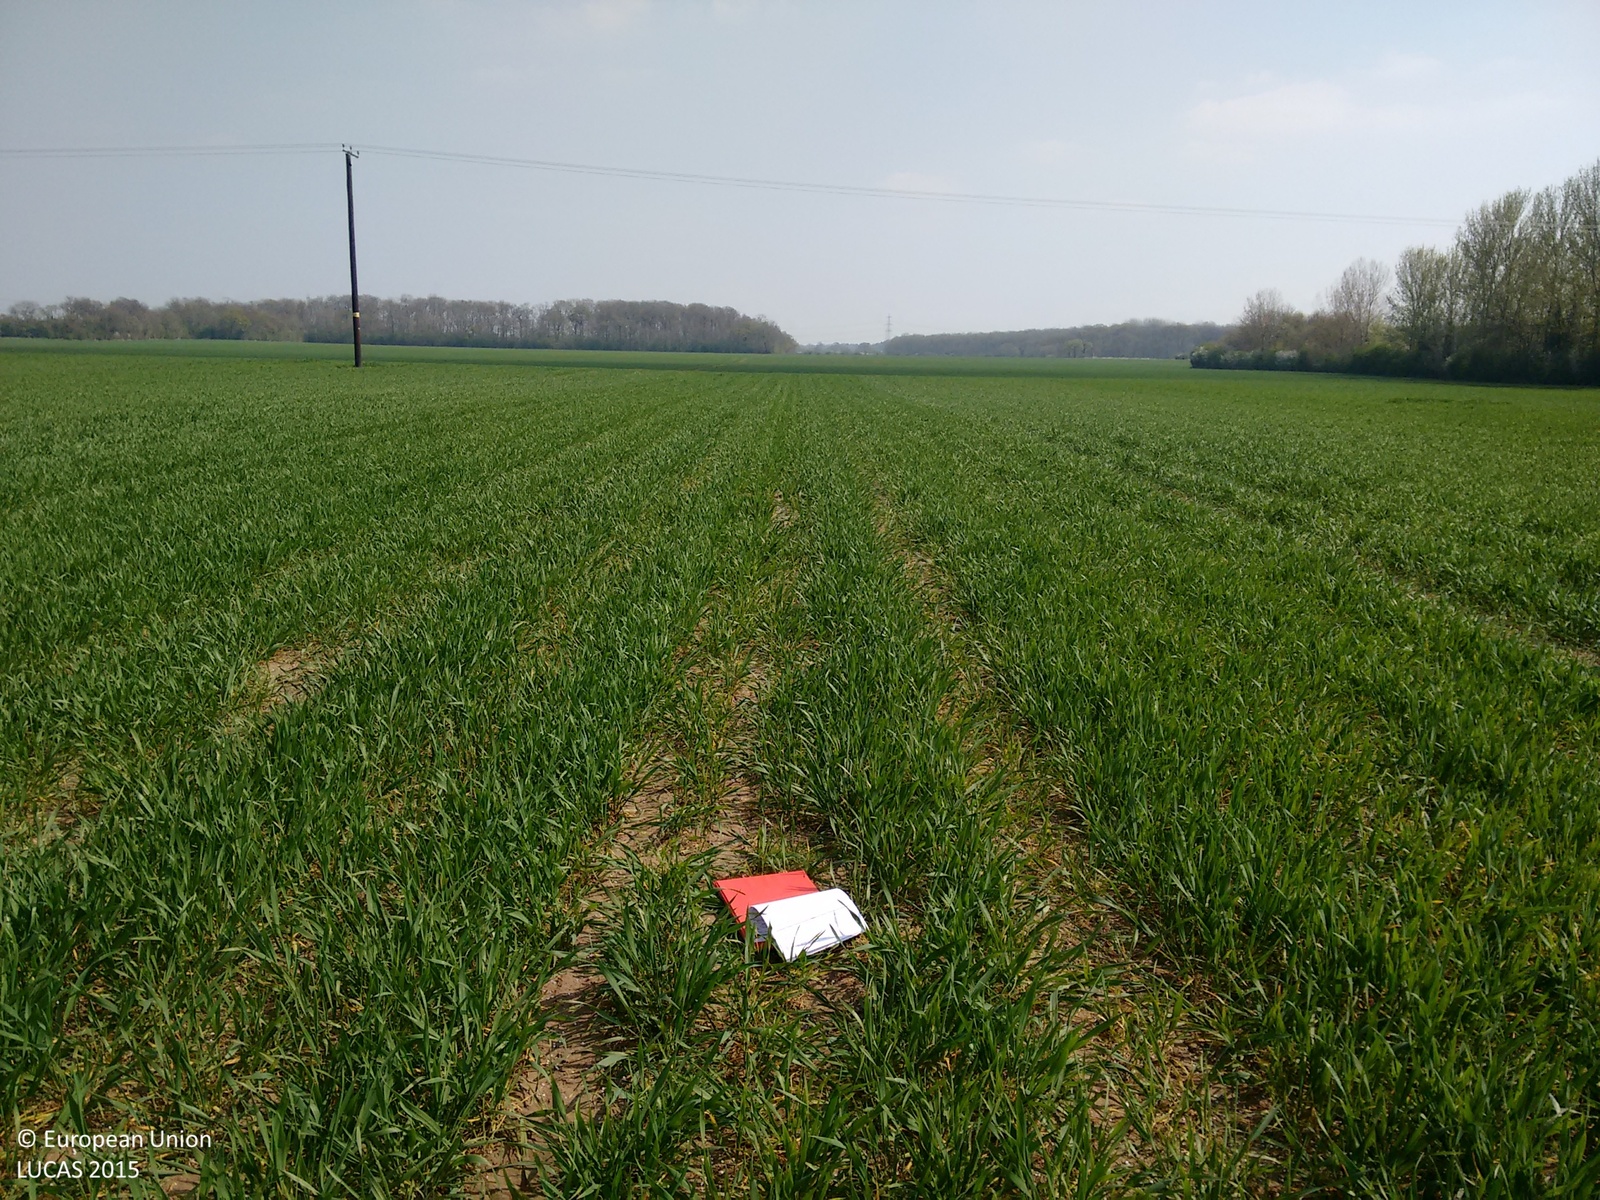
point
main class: Cropland
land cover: Common wheat
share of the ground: 50 - 75 %
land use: Agriculture (excluding fallow land and kitchen gardens)
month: April
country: GB
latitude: 53.2178
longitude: -0.6878
